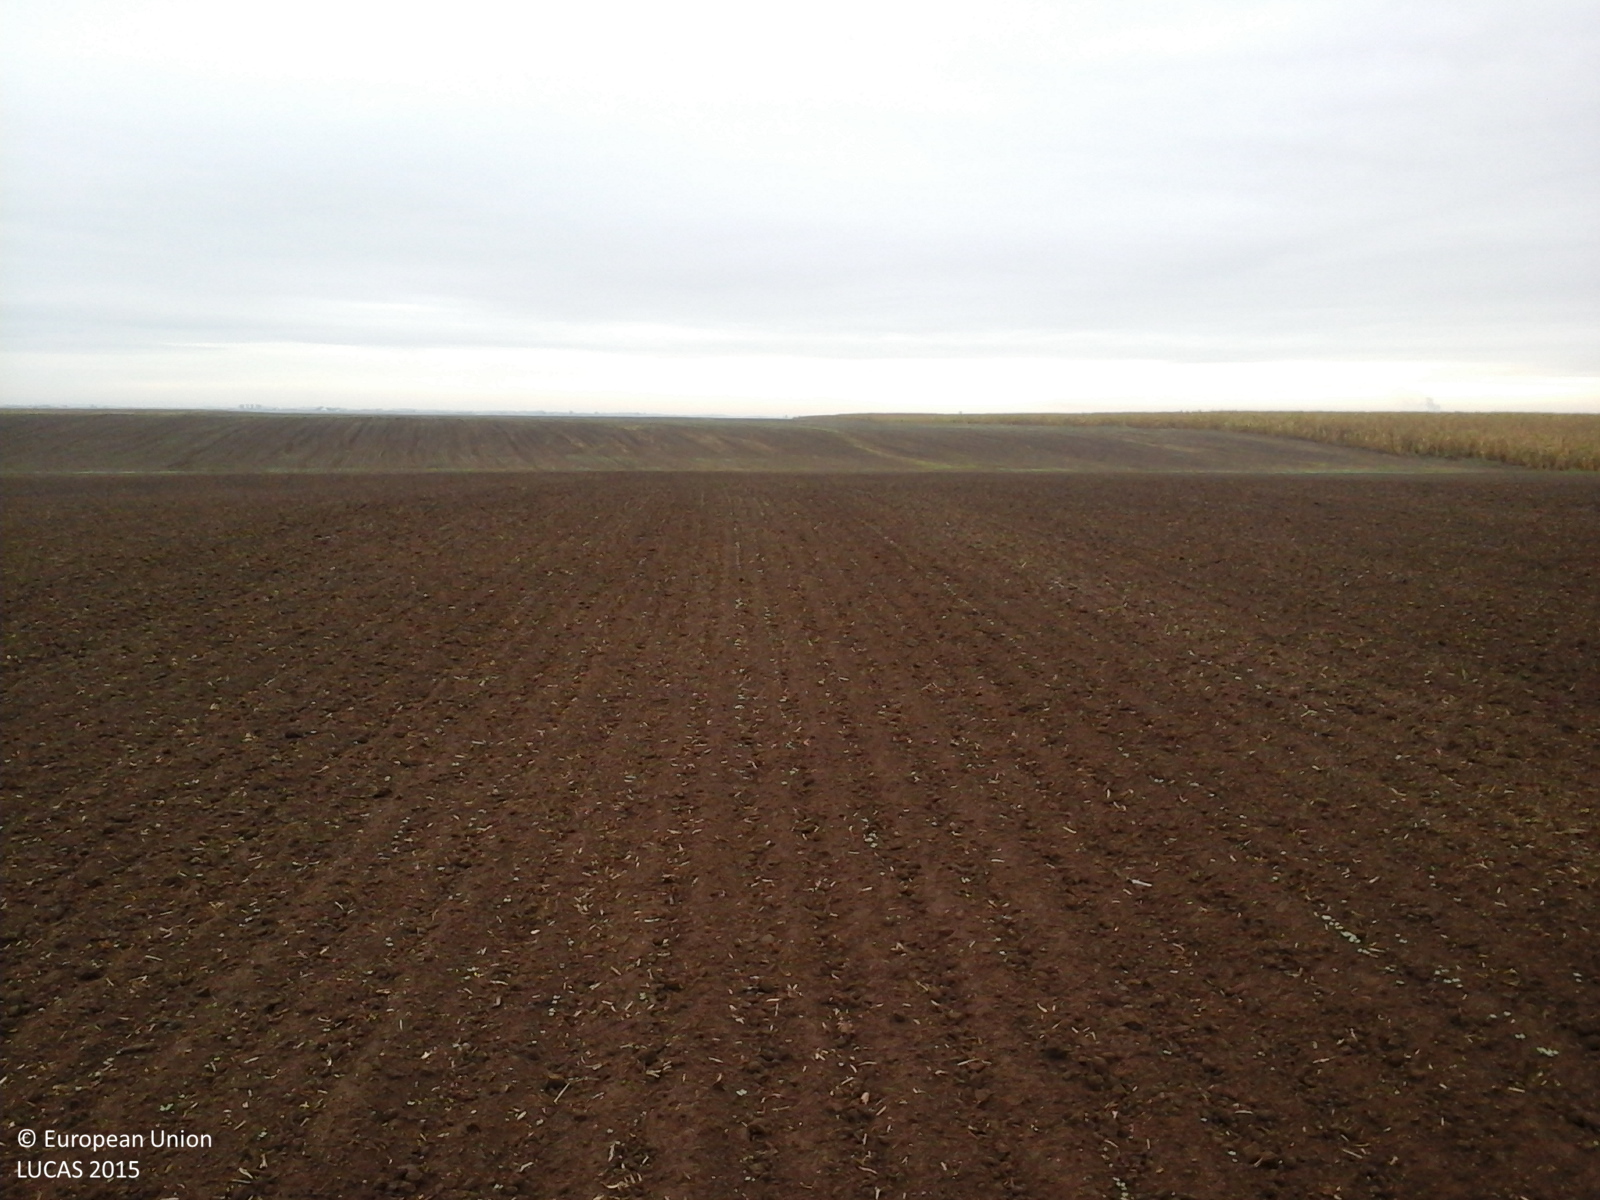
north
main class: Cropland
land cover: Common wheat
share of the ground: < 10 %
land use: Agriculture (excluding fallow land and kitchen gardens)
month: September
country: RO
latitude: 47.0242
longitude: 21.7936
